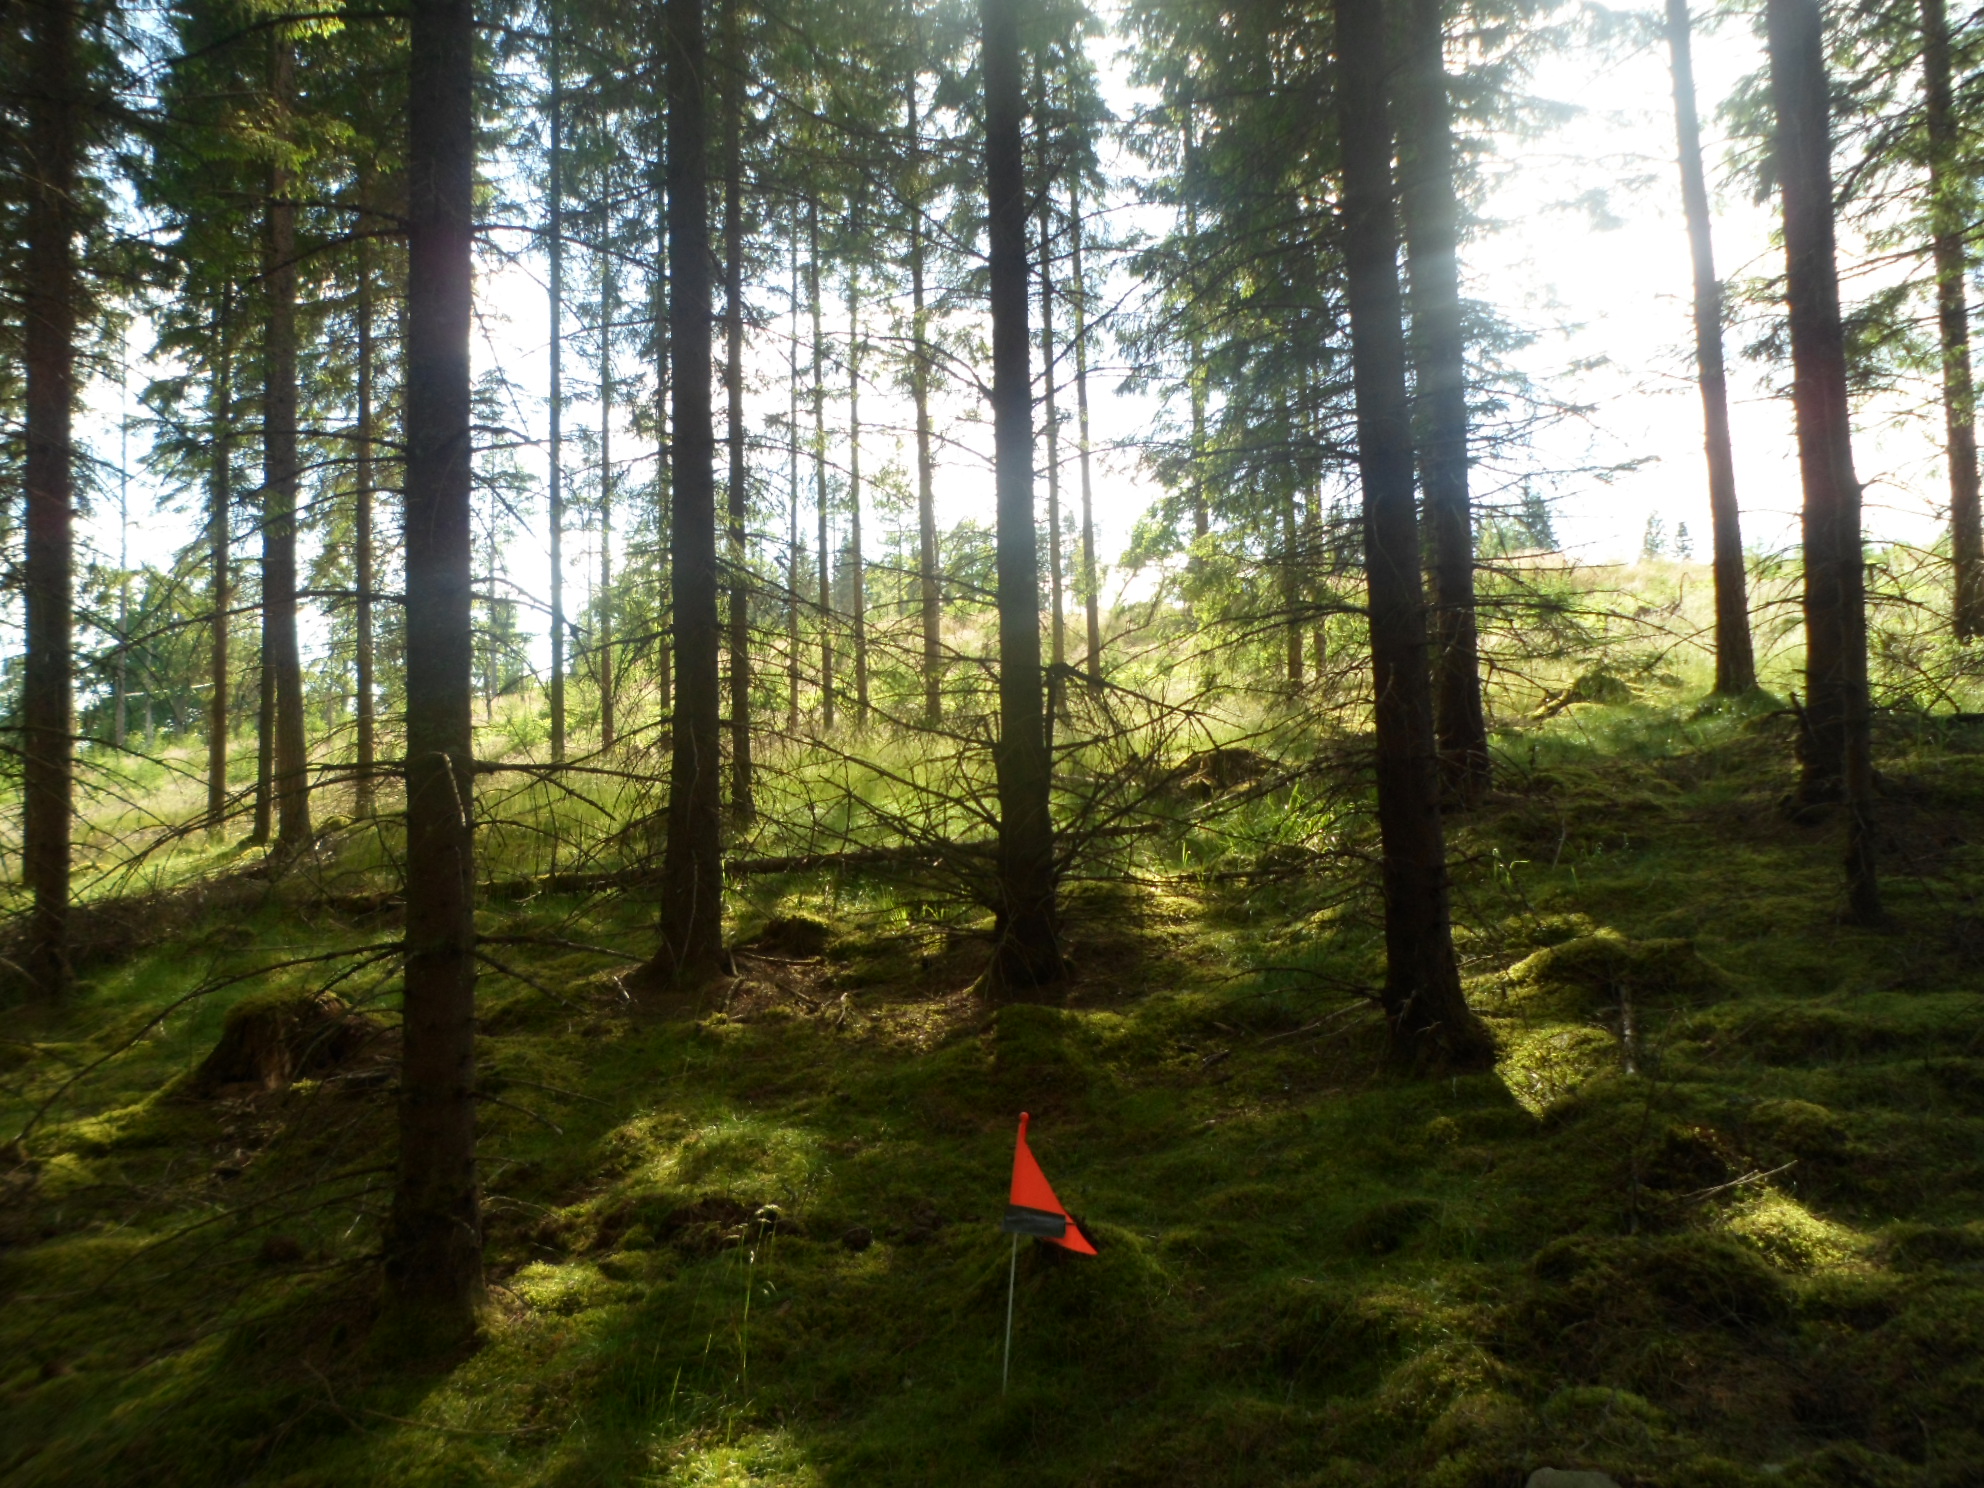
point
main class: Woodland
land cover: Spruce dominated coniferous woodland
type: boreal forest
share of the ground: 50 - 75 %
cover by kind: coniferous forest trees 60 %, lichens and mosses 25 %, herbaceous plants 15 %
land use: Forestry
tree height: > 5 m
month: July
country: SE
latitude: 57.5545
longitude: 14.3574
